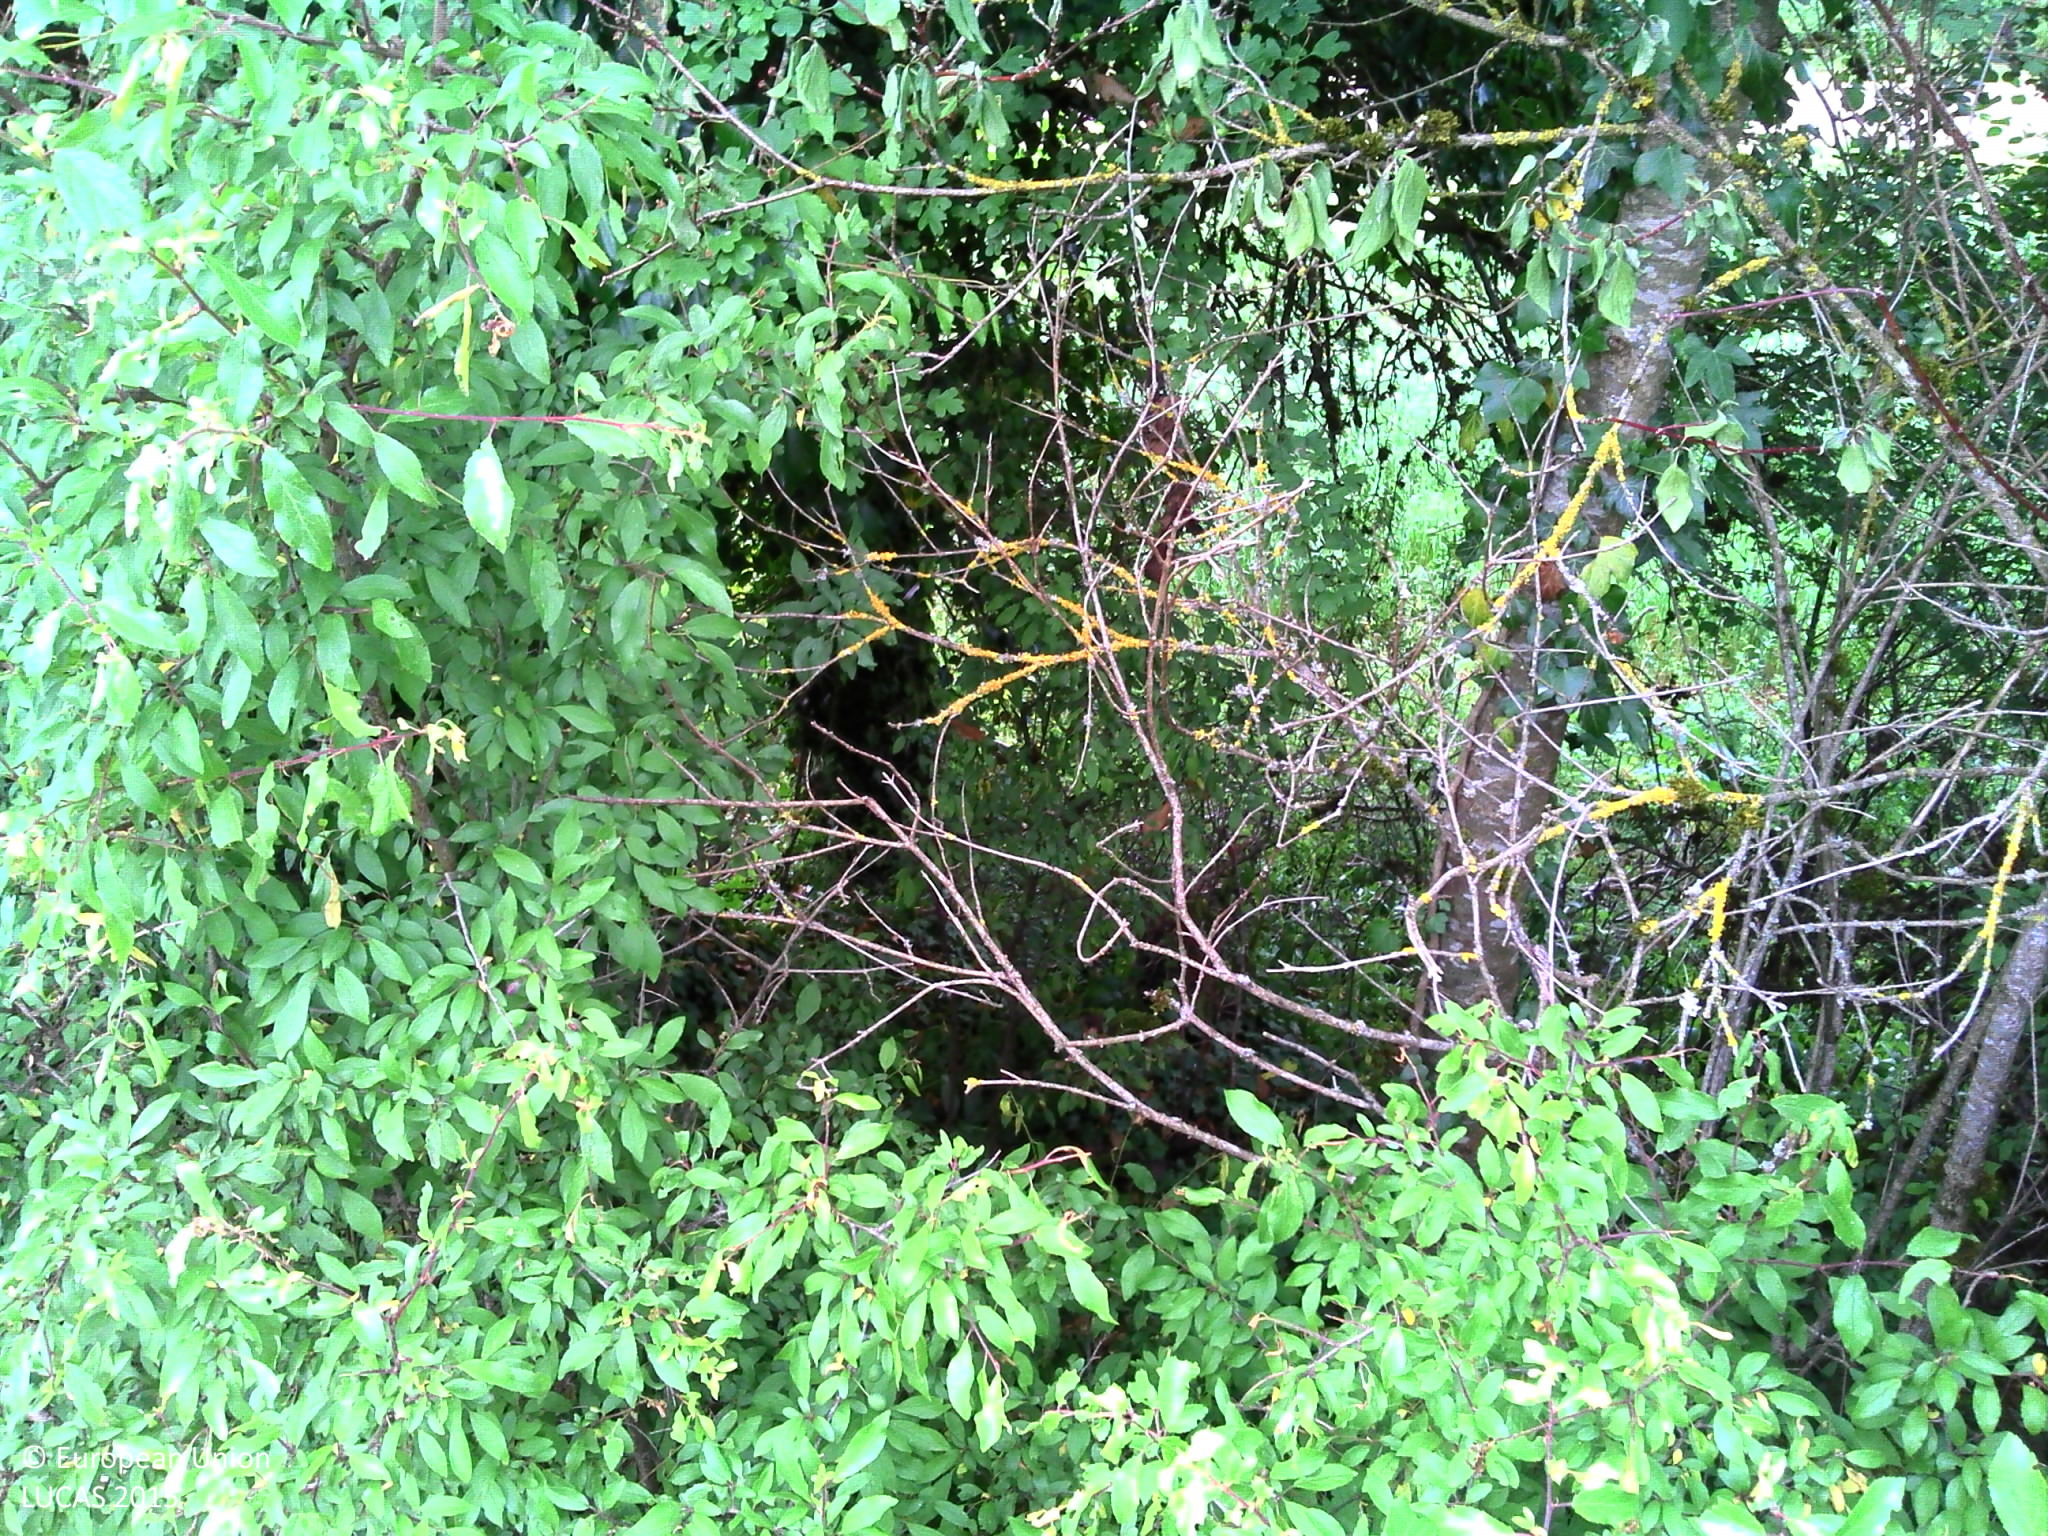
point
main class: Woodland
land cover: Broadleaved woodland
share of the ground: > 75 %
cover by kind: broadleaved forest trees 95 %, shrubs 5 %
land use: Semi-natural and natural areas not in use
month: June
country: FR
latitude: 47.5962
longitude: 5.1991
